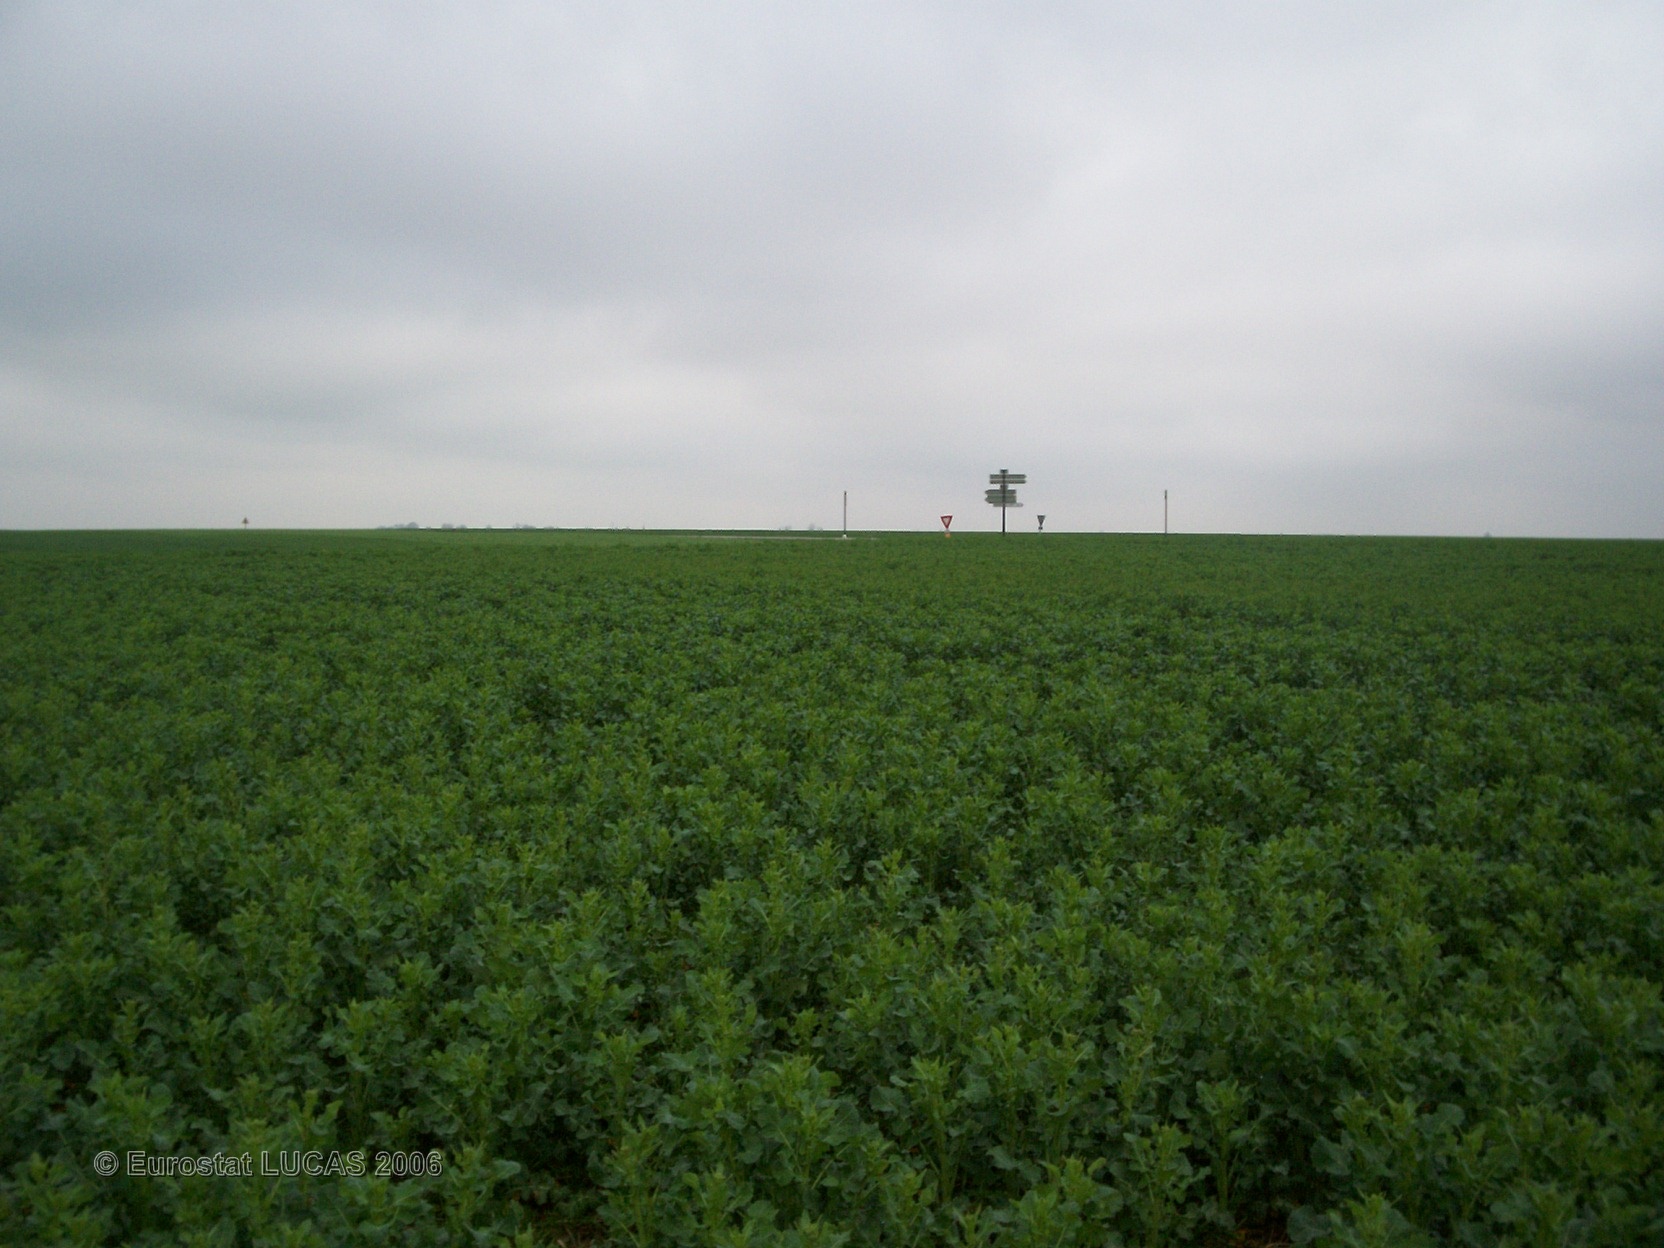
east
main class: Cropland
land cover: Rape and turnip rape
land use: Agriculture (excluding fallow land and kitchen gardens)
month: April
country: FR
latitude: 49.2135
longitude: 1.0139
